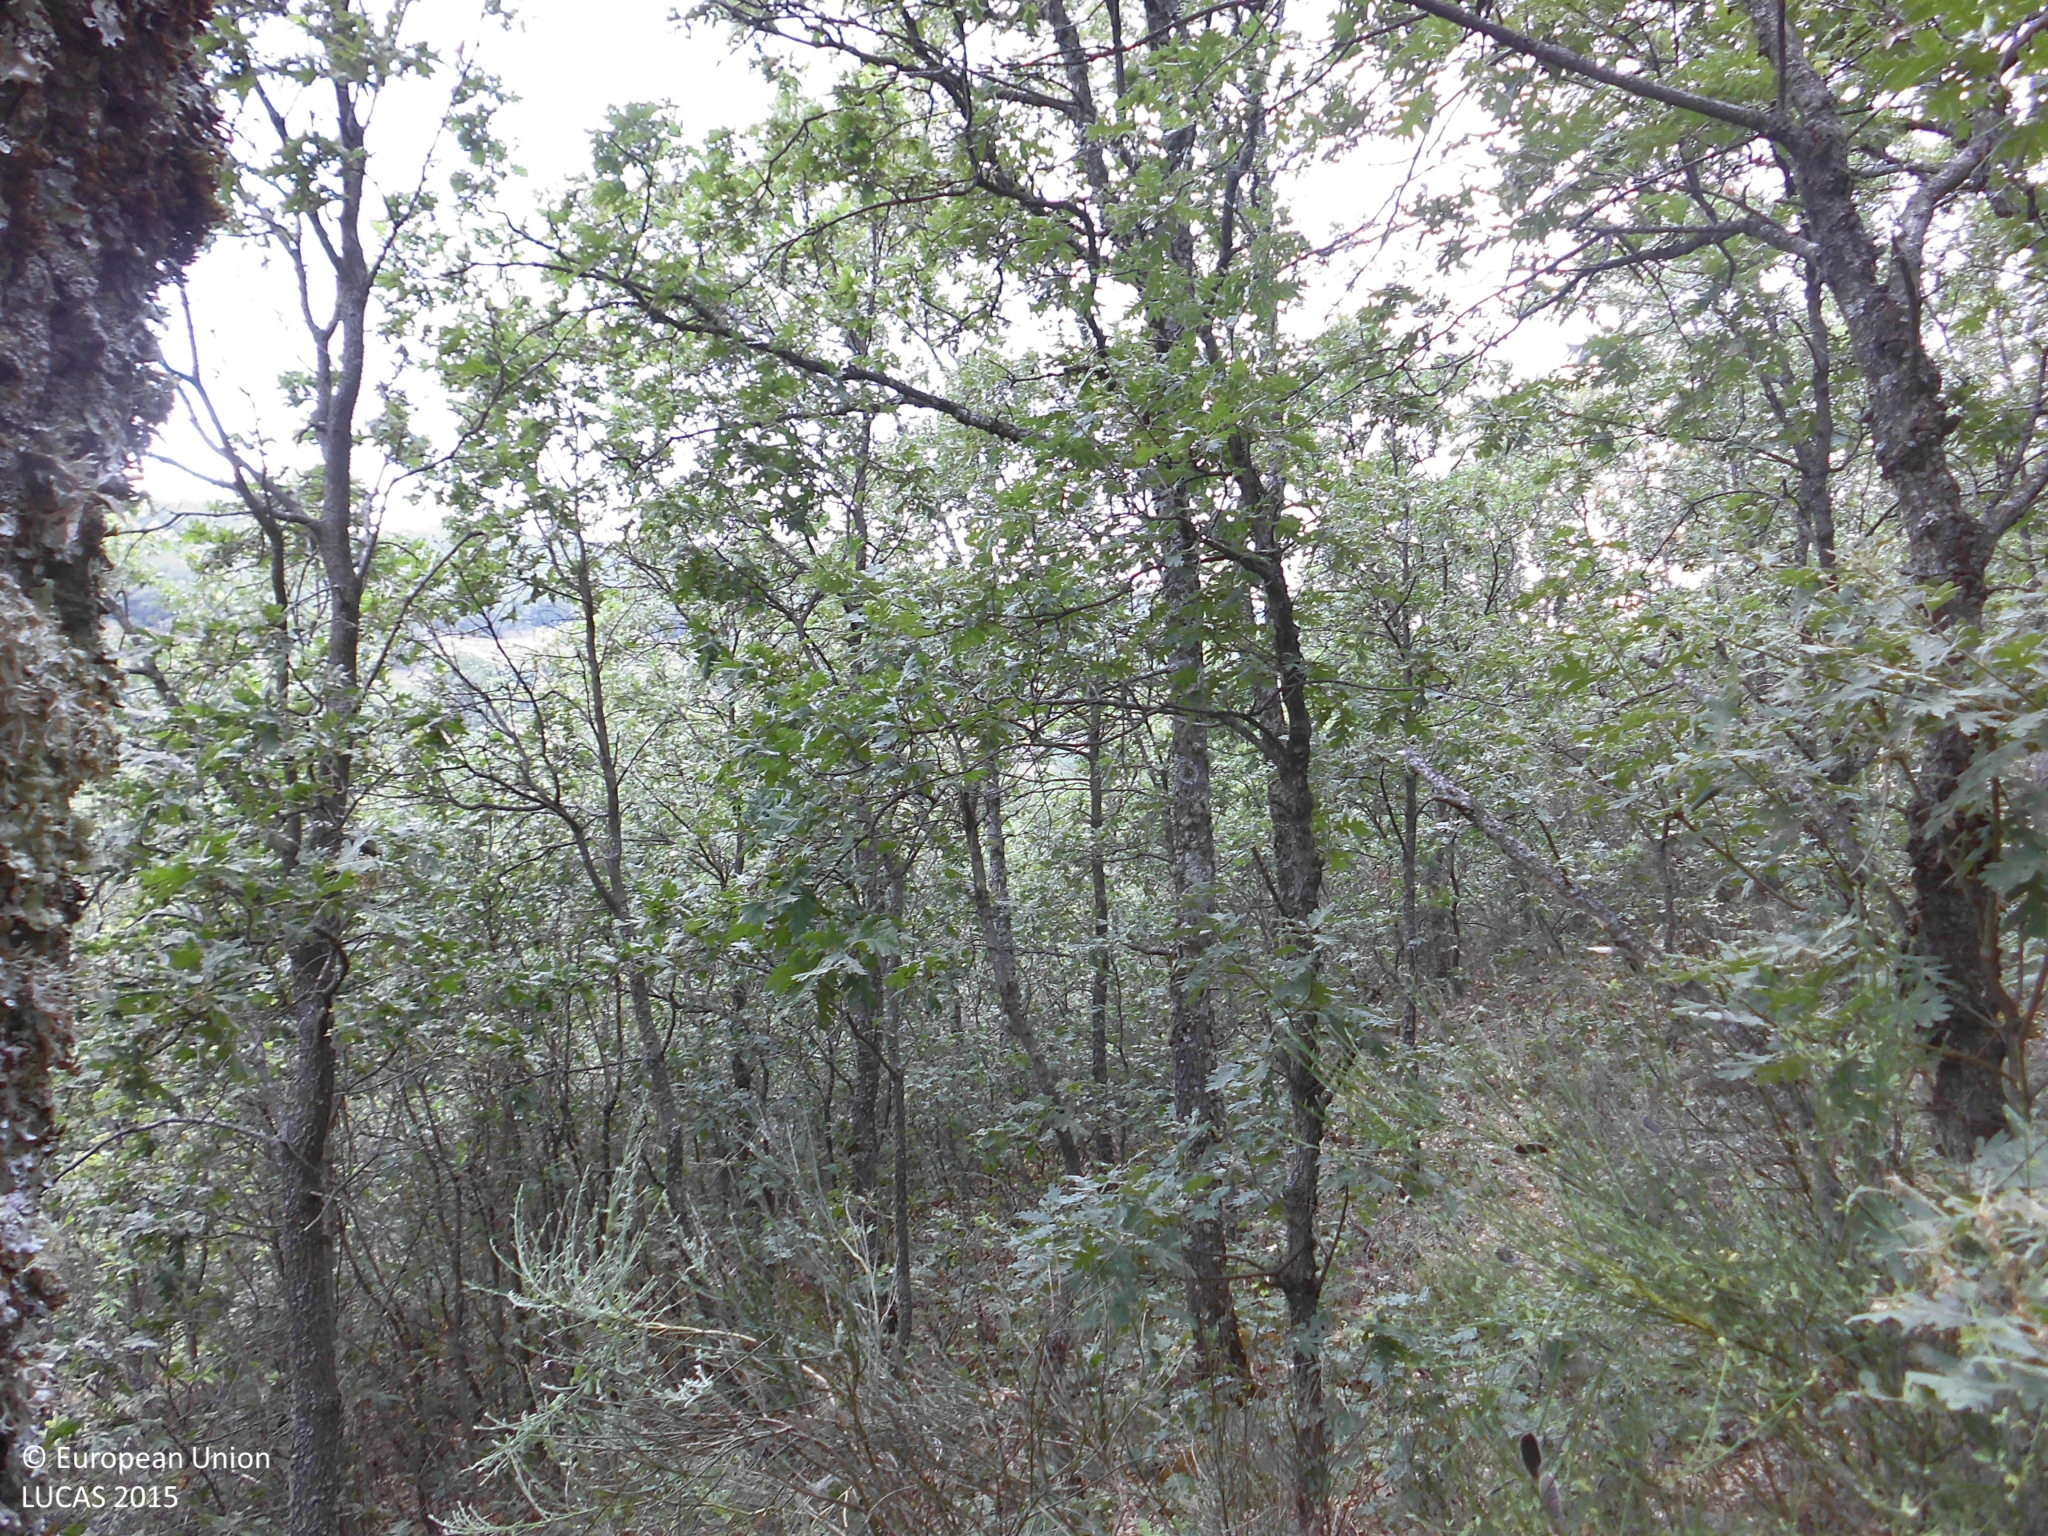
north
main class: Shrubland
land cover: Shrubland with sparse tree cover
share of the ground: > 75 %
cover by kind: shrubs 90 %, broadleaved forest trees 5 %, herbaceous plants 5 %
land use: Agriculture (excluding fallow land and kitchen gardens)
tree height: > 5 m
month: June
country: ES
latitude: 40.0575
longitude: -5.8345
